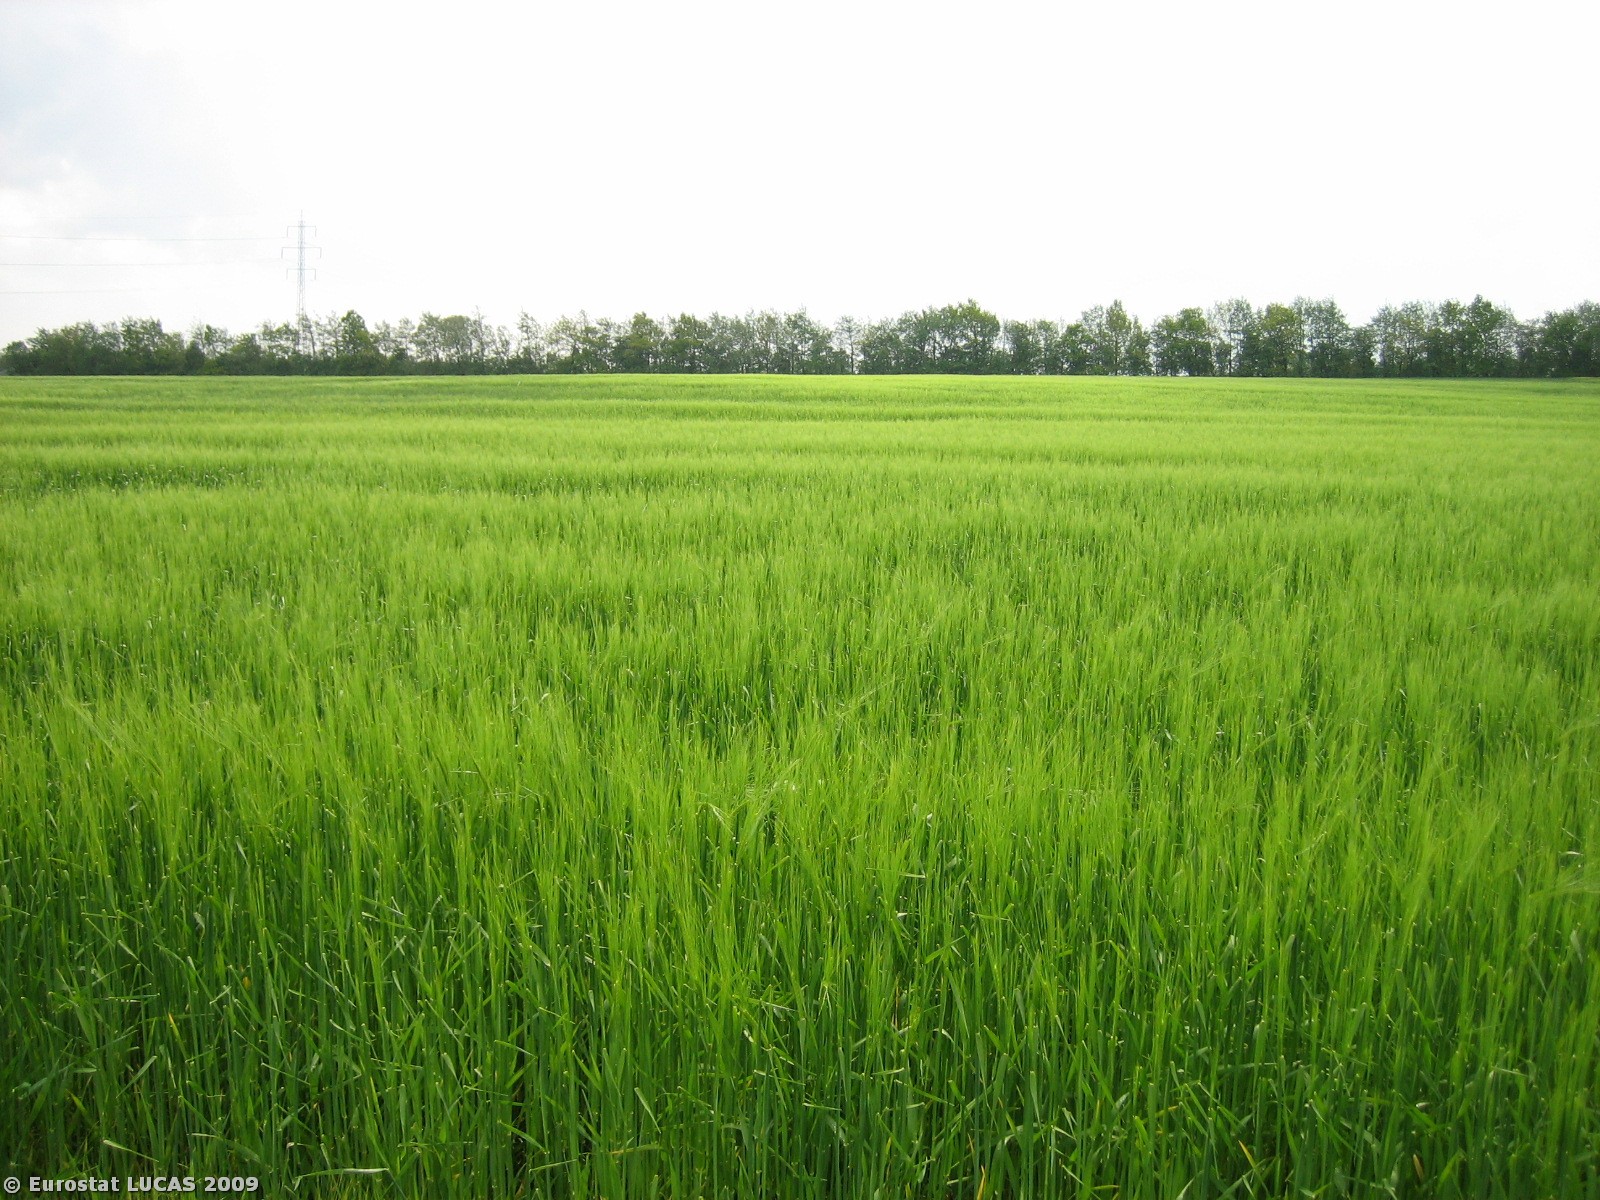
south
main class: Cropland
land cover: Barley
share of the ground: > 75 %
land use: Agriculture (excluding fallow land and kitchen gardens)
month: May
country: DK
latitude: 56.1801
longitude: 8.6000
